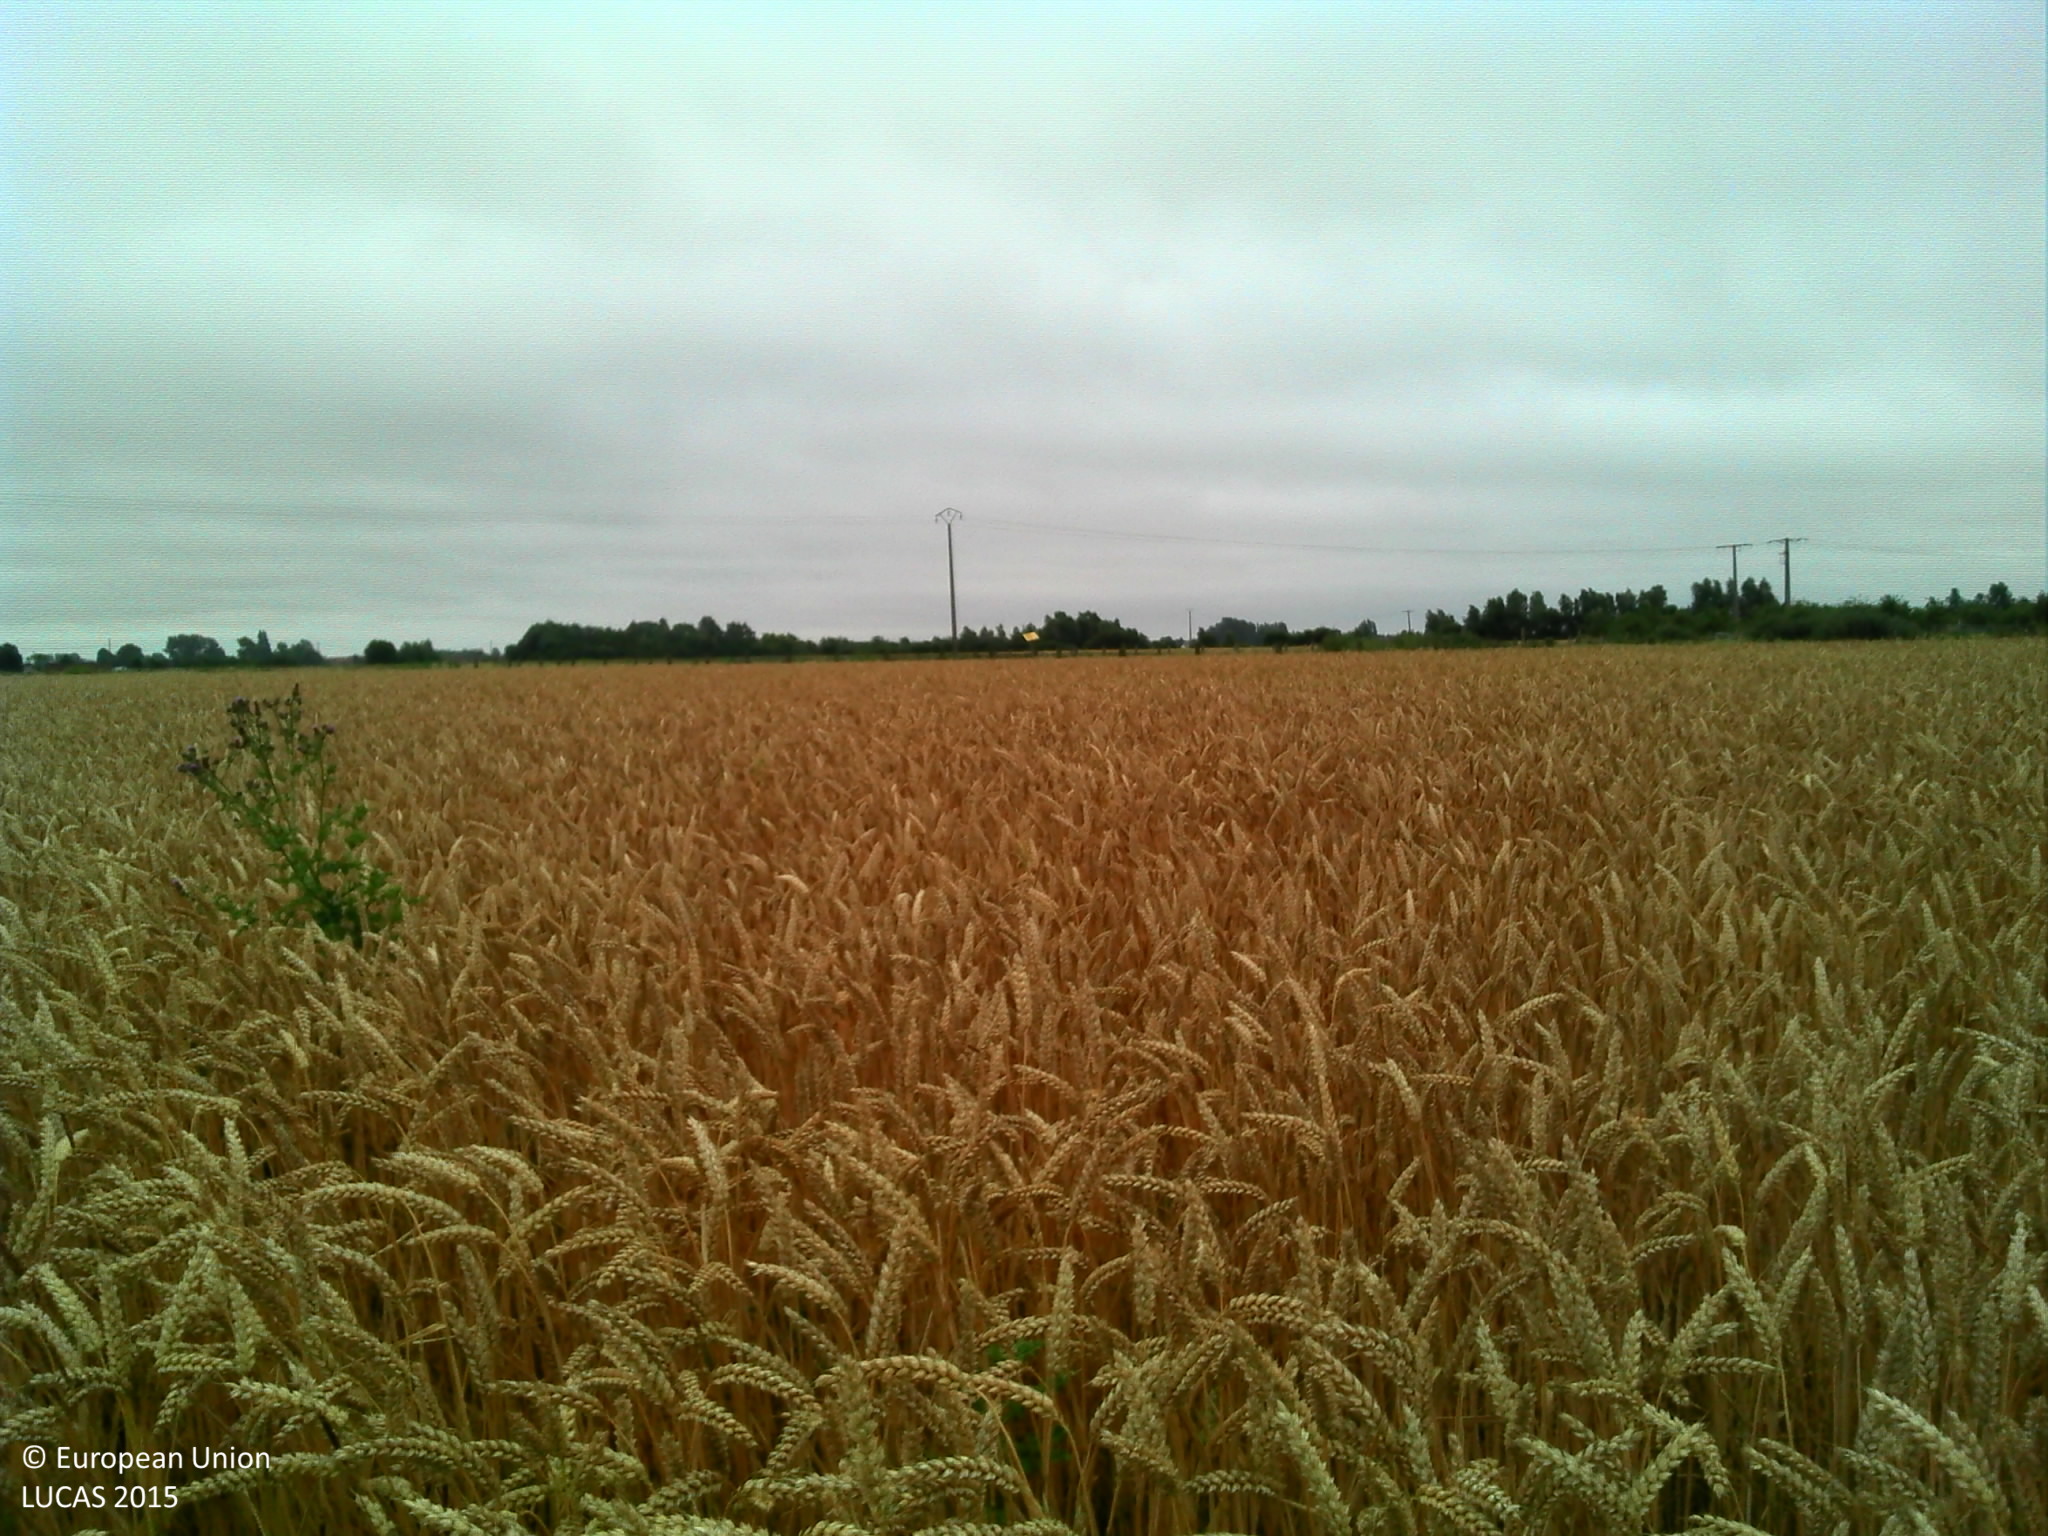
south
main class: Cropland
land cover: Common wheat
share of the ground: > 75 %
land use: Agriculture (excluding fallow land and kitchen gardens)
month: July
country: FR
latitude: 50.9701
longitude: 2.2818
